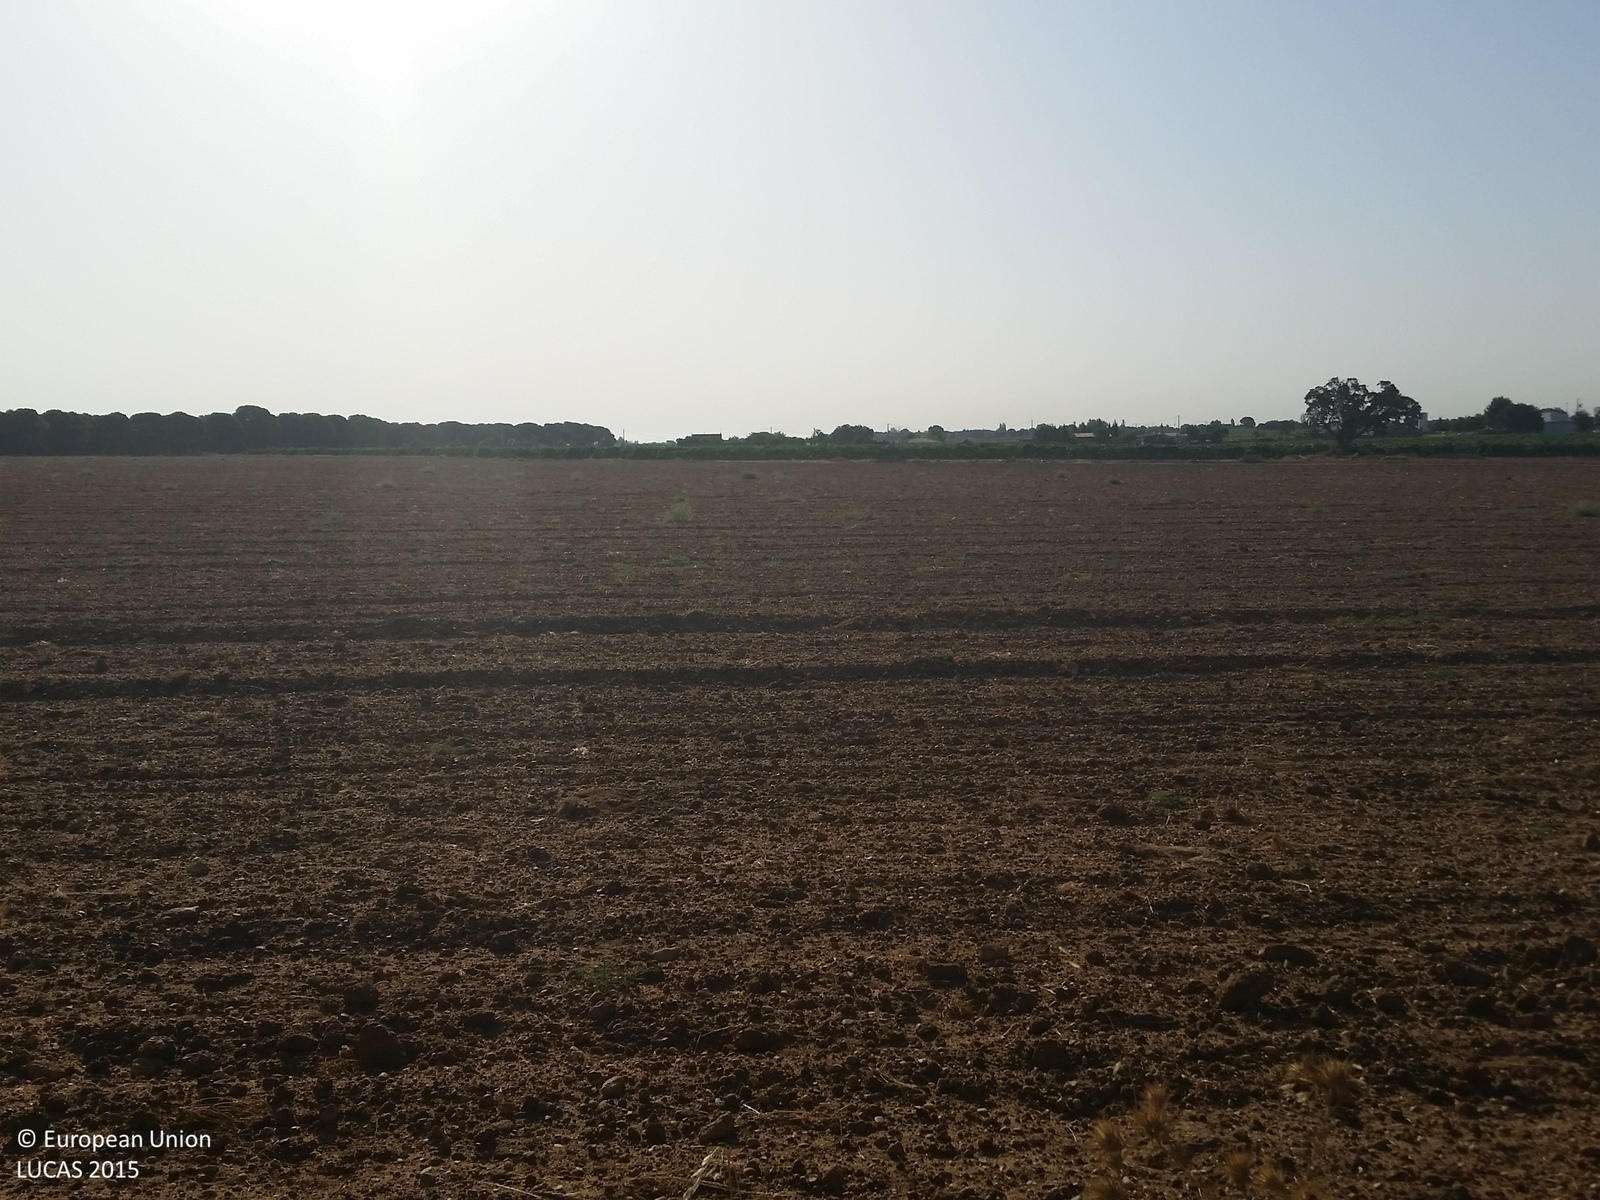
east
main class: Woodland
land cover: Pine dominated coniferous woodland
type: coniferous forest of the mediterranean region
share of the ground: 10 - 25 %
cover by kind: herbaceous plants 90 %, coniferous forest trees 10 %
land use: Forestry
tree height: < 5 m
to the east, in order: Pine dominated coniferous woodland; Grassland without tree/shrub cover; Other bare soil; Tracks; Vineyards
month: July
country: ES
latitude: 39.3119
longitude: -2.6878
